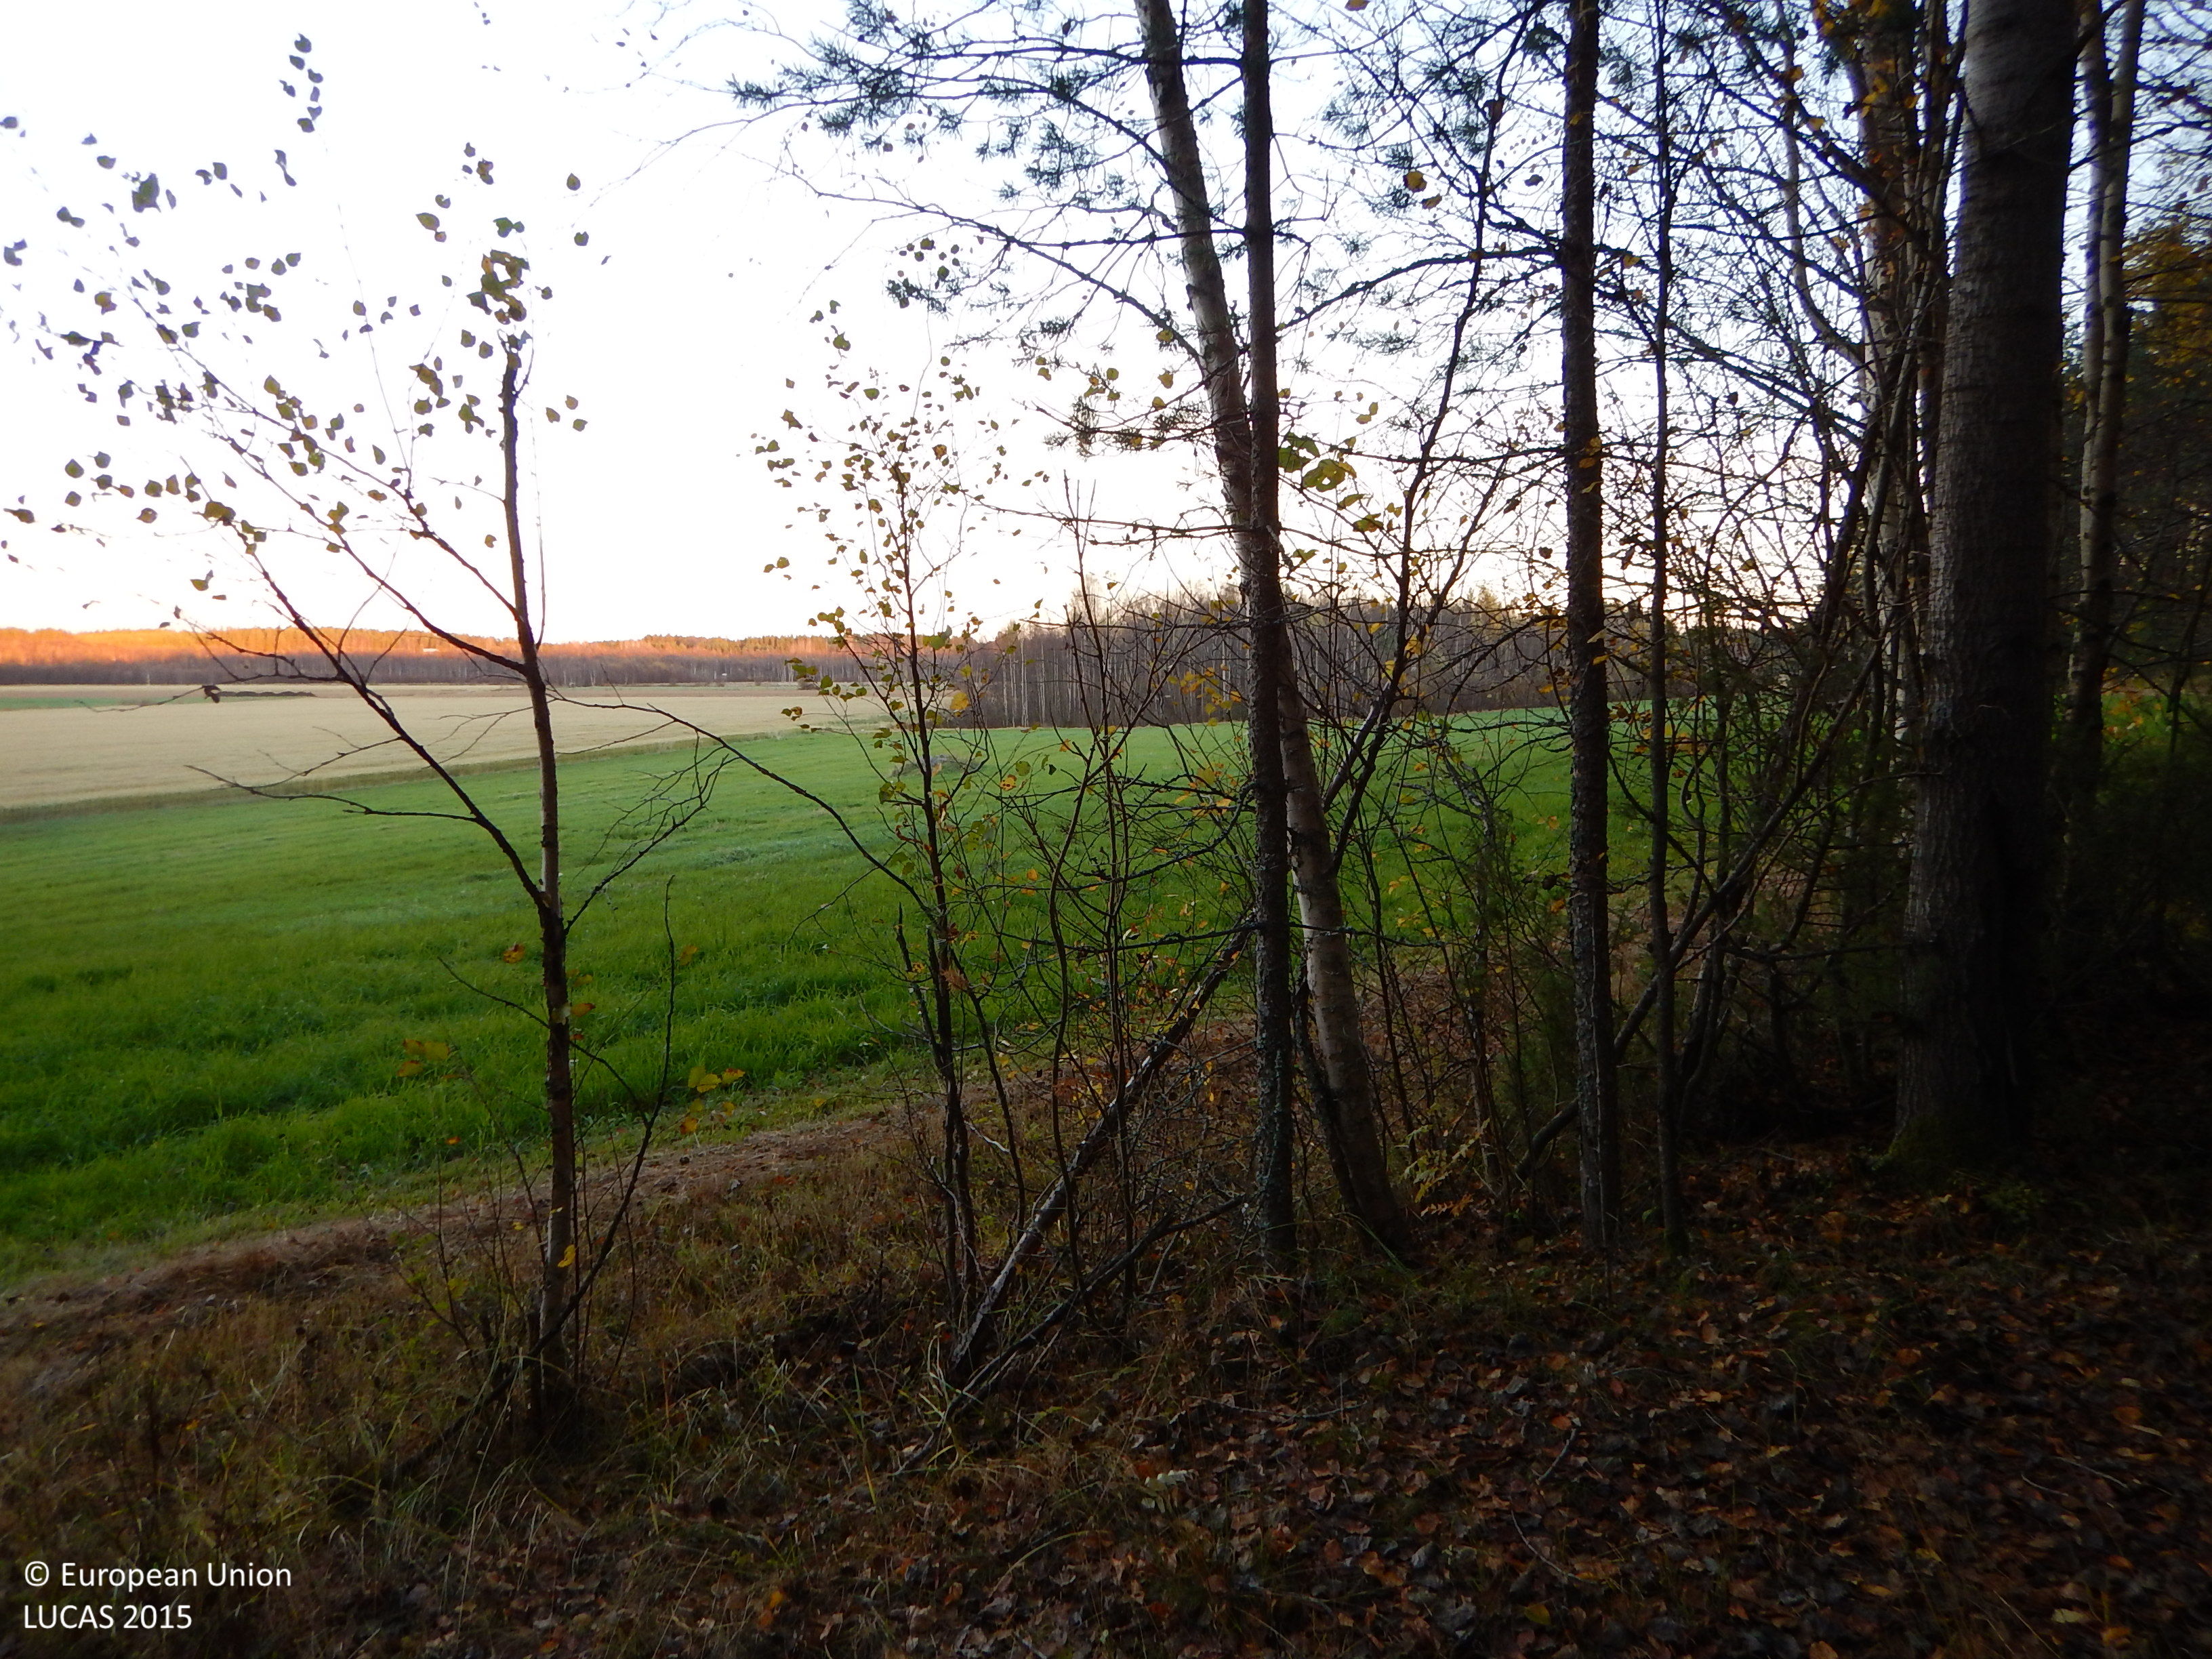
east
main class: Woodland
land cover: Pine dominated mixed woodland
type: boreal forest
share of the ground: 50 - 75 %
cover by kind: coniferous forest trees 40 %, broadleaved forest trees 20 %, shrubs 20 %, herbaceous plants 10 %, lichens and mosses 10 %
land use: Forestry
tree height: > 5 m
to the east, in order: Tracks; Groves; Temporary grasslands; Common wheat
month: October
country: SE
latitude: 64.8876
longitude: 21.0643
